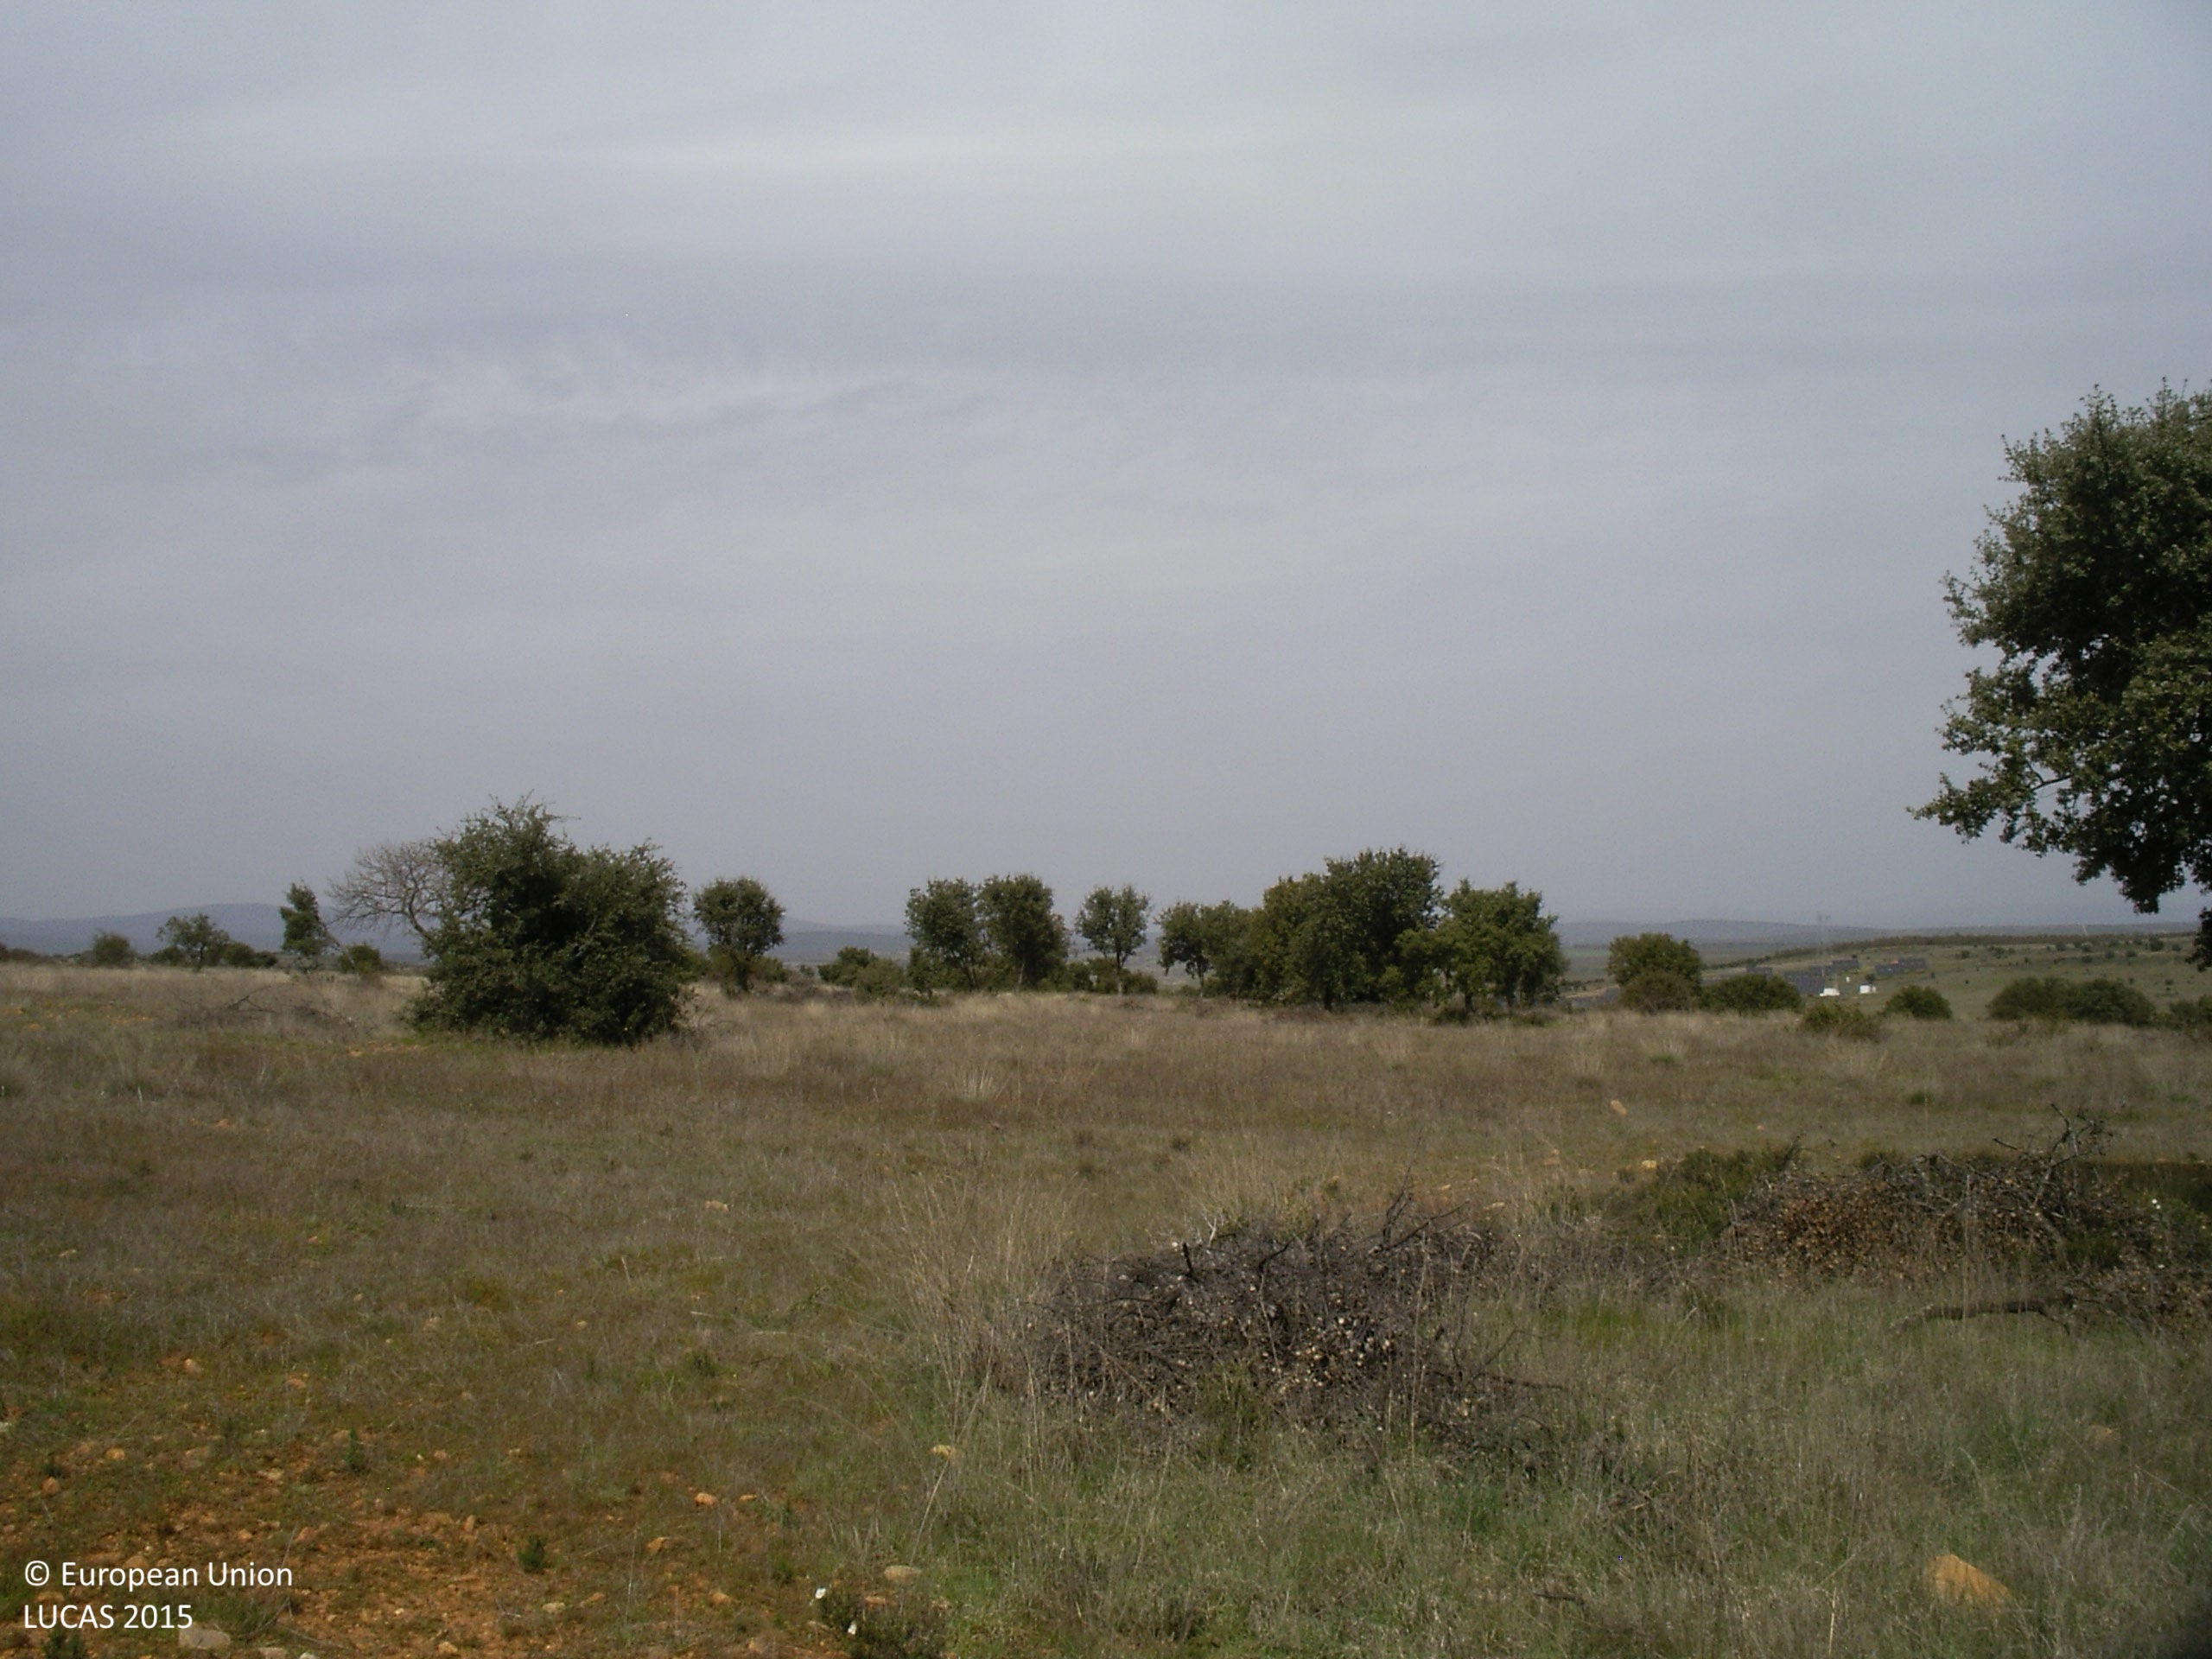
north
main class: Shrubland
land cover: Shrubland with sparse tree cover
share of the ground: > 75 %
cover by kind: herbaceous plants 85 %, shrubs 10 %, broadleaved forest trees 5 %
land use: Agriculture (excluding fallow land and kitchen gardens)
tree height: > 5 m
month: April
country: ES
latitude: 42.3987
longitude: -6.1312
